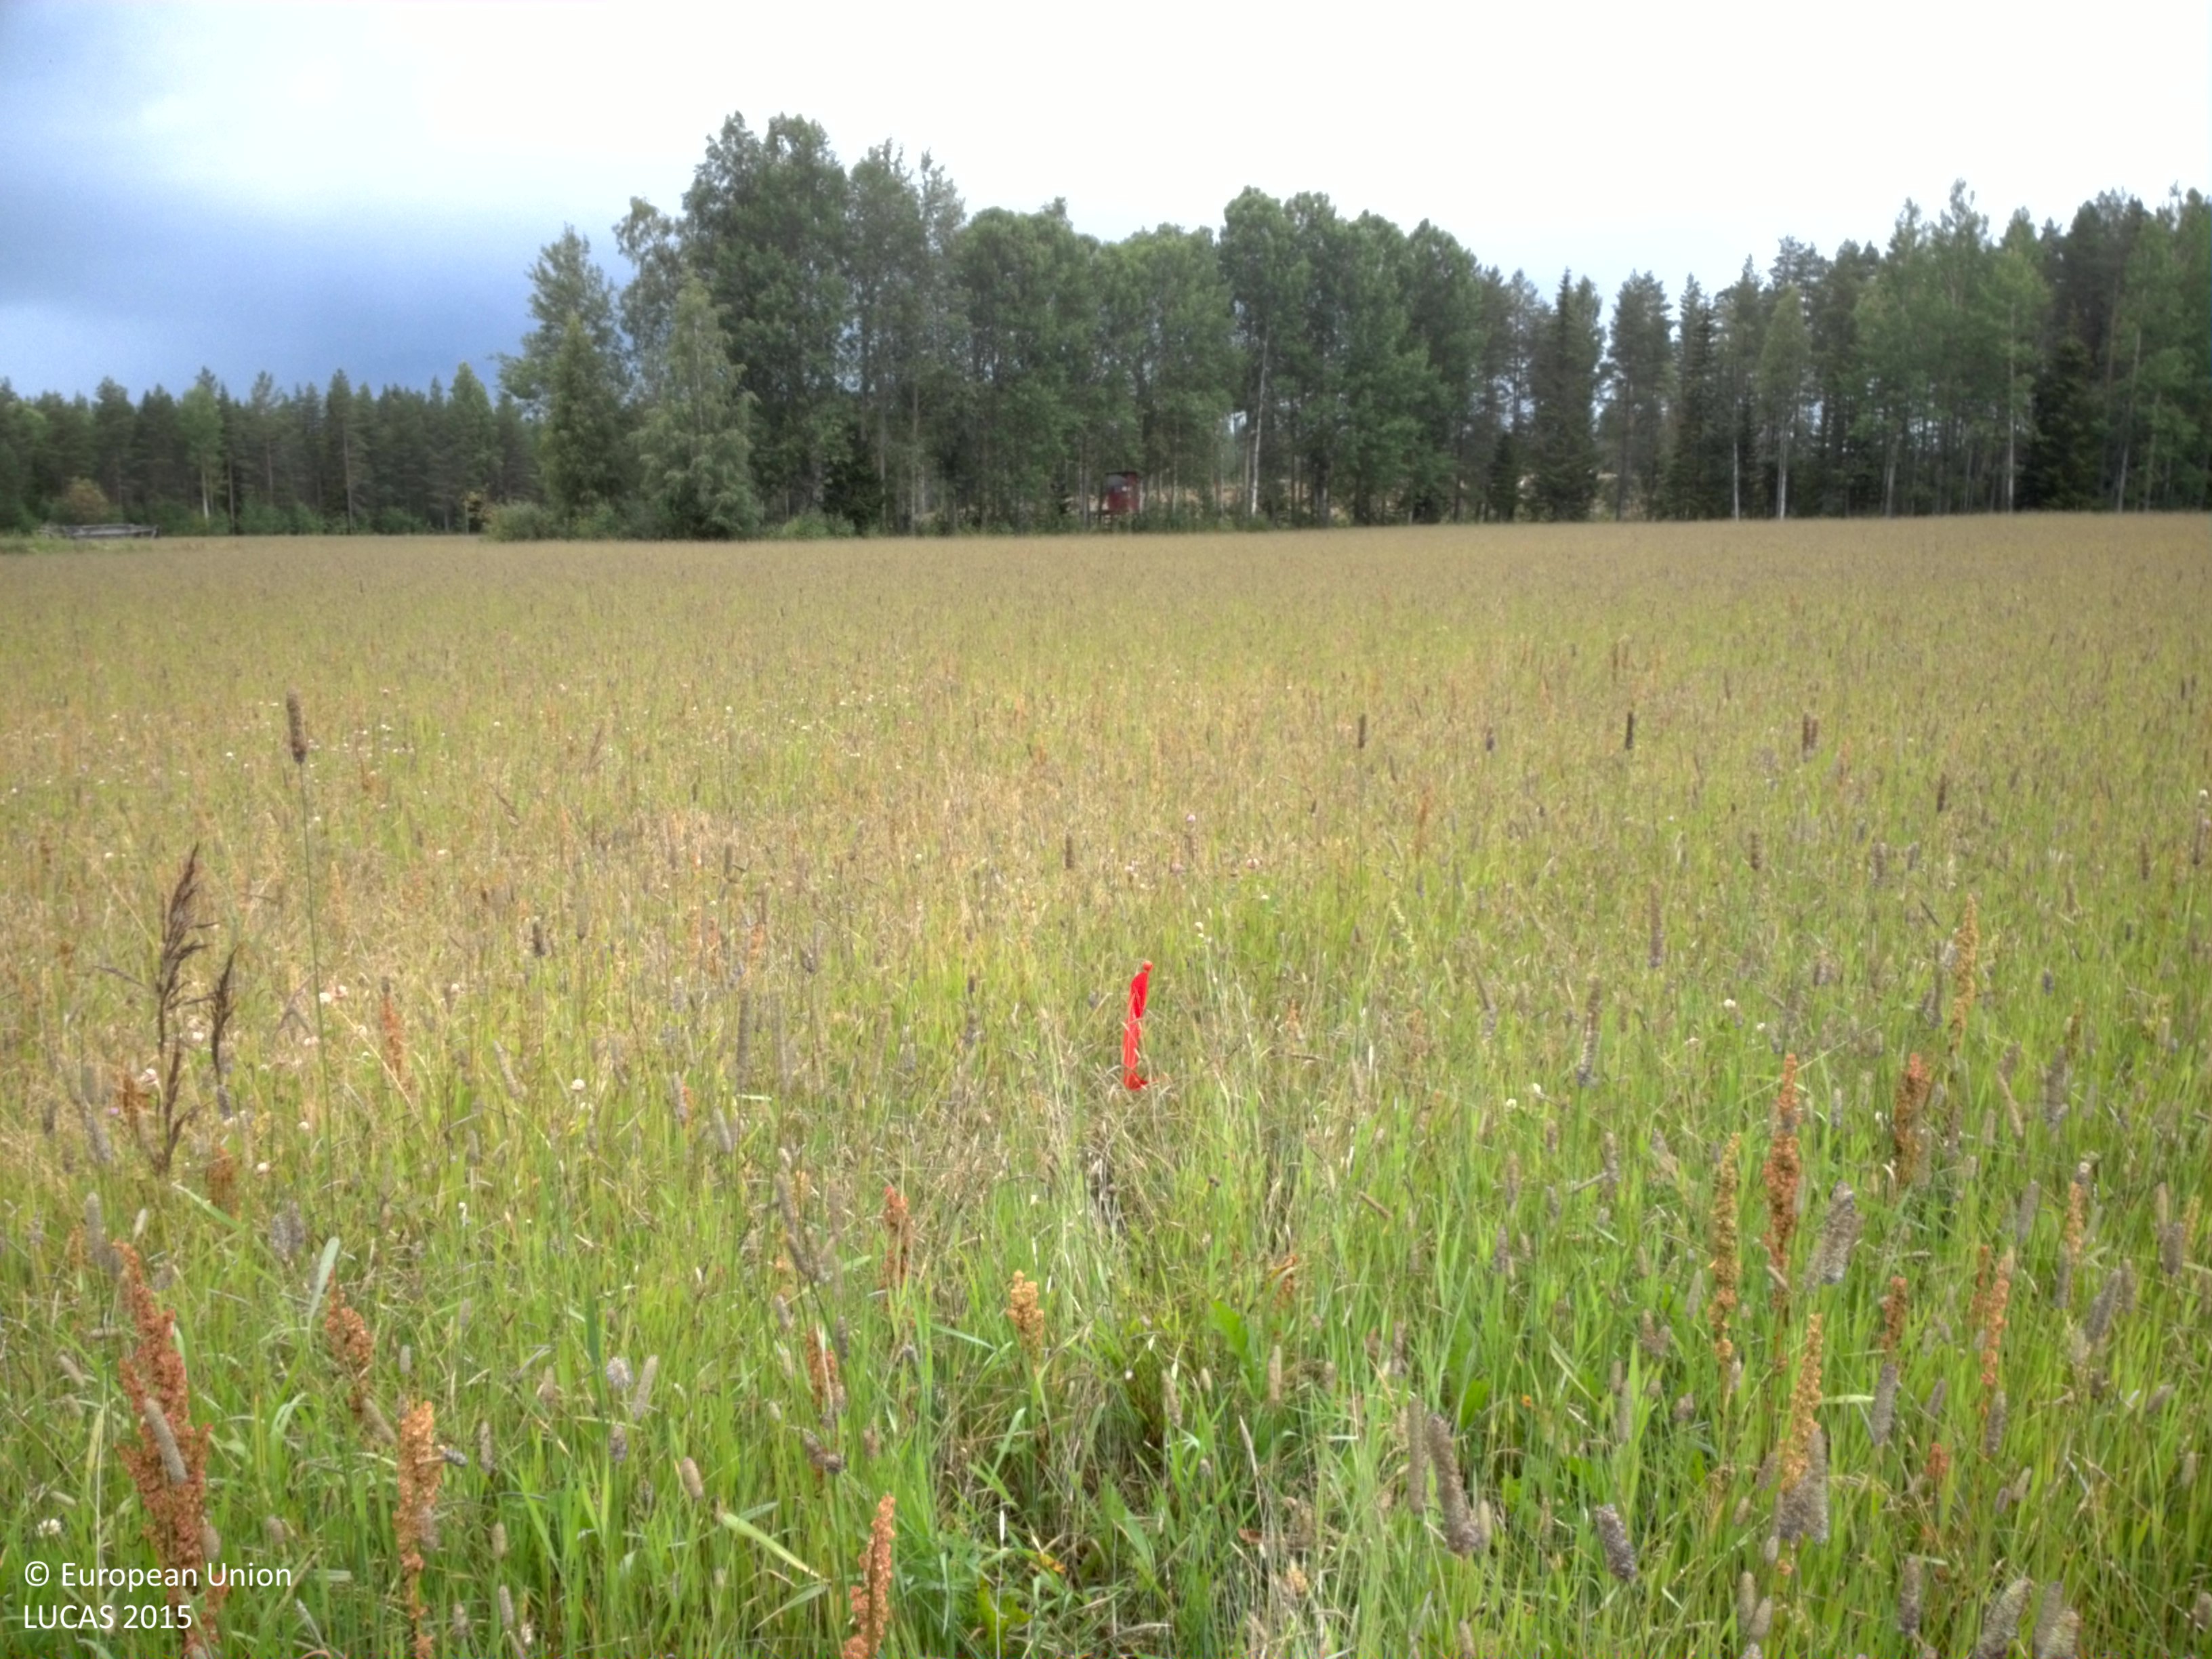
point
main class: Grassland
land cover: Grassland without tree/shrub cover
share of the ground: > 75 %
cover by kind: herbaceous plants 100 %
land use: Agriculture (excluding fallow land and kitchen gardens)
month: August
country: SE
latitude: 64.7275
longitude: 20.9999
